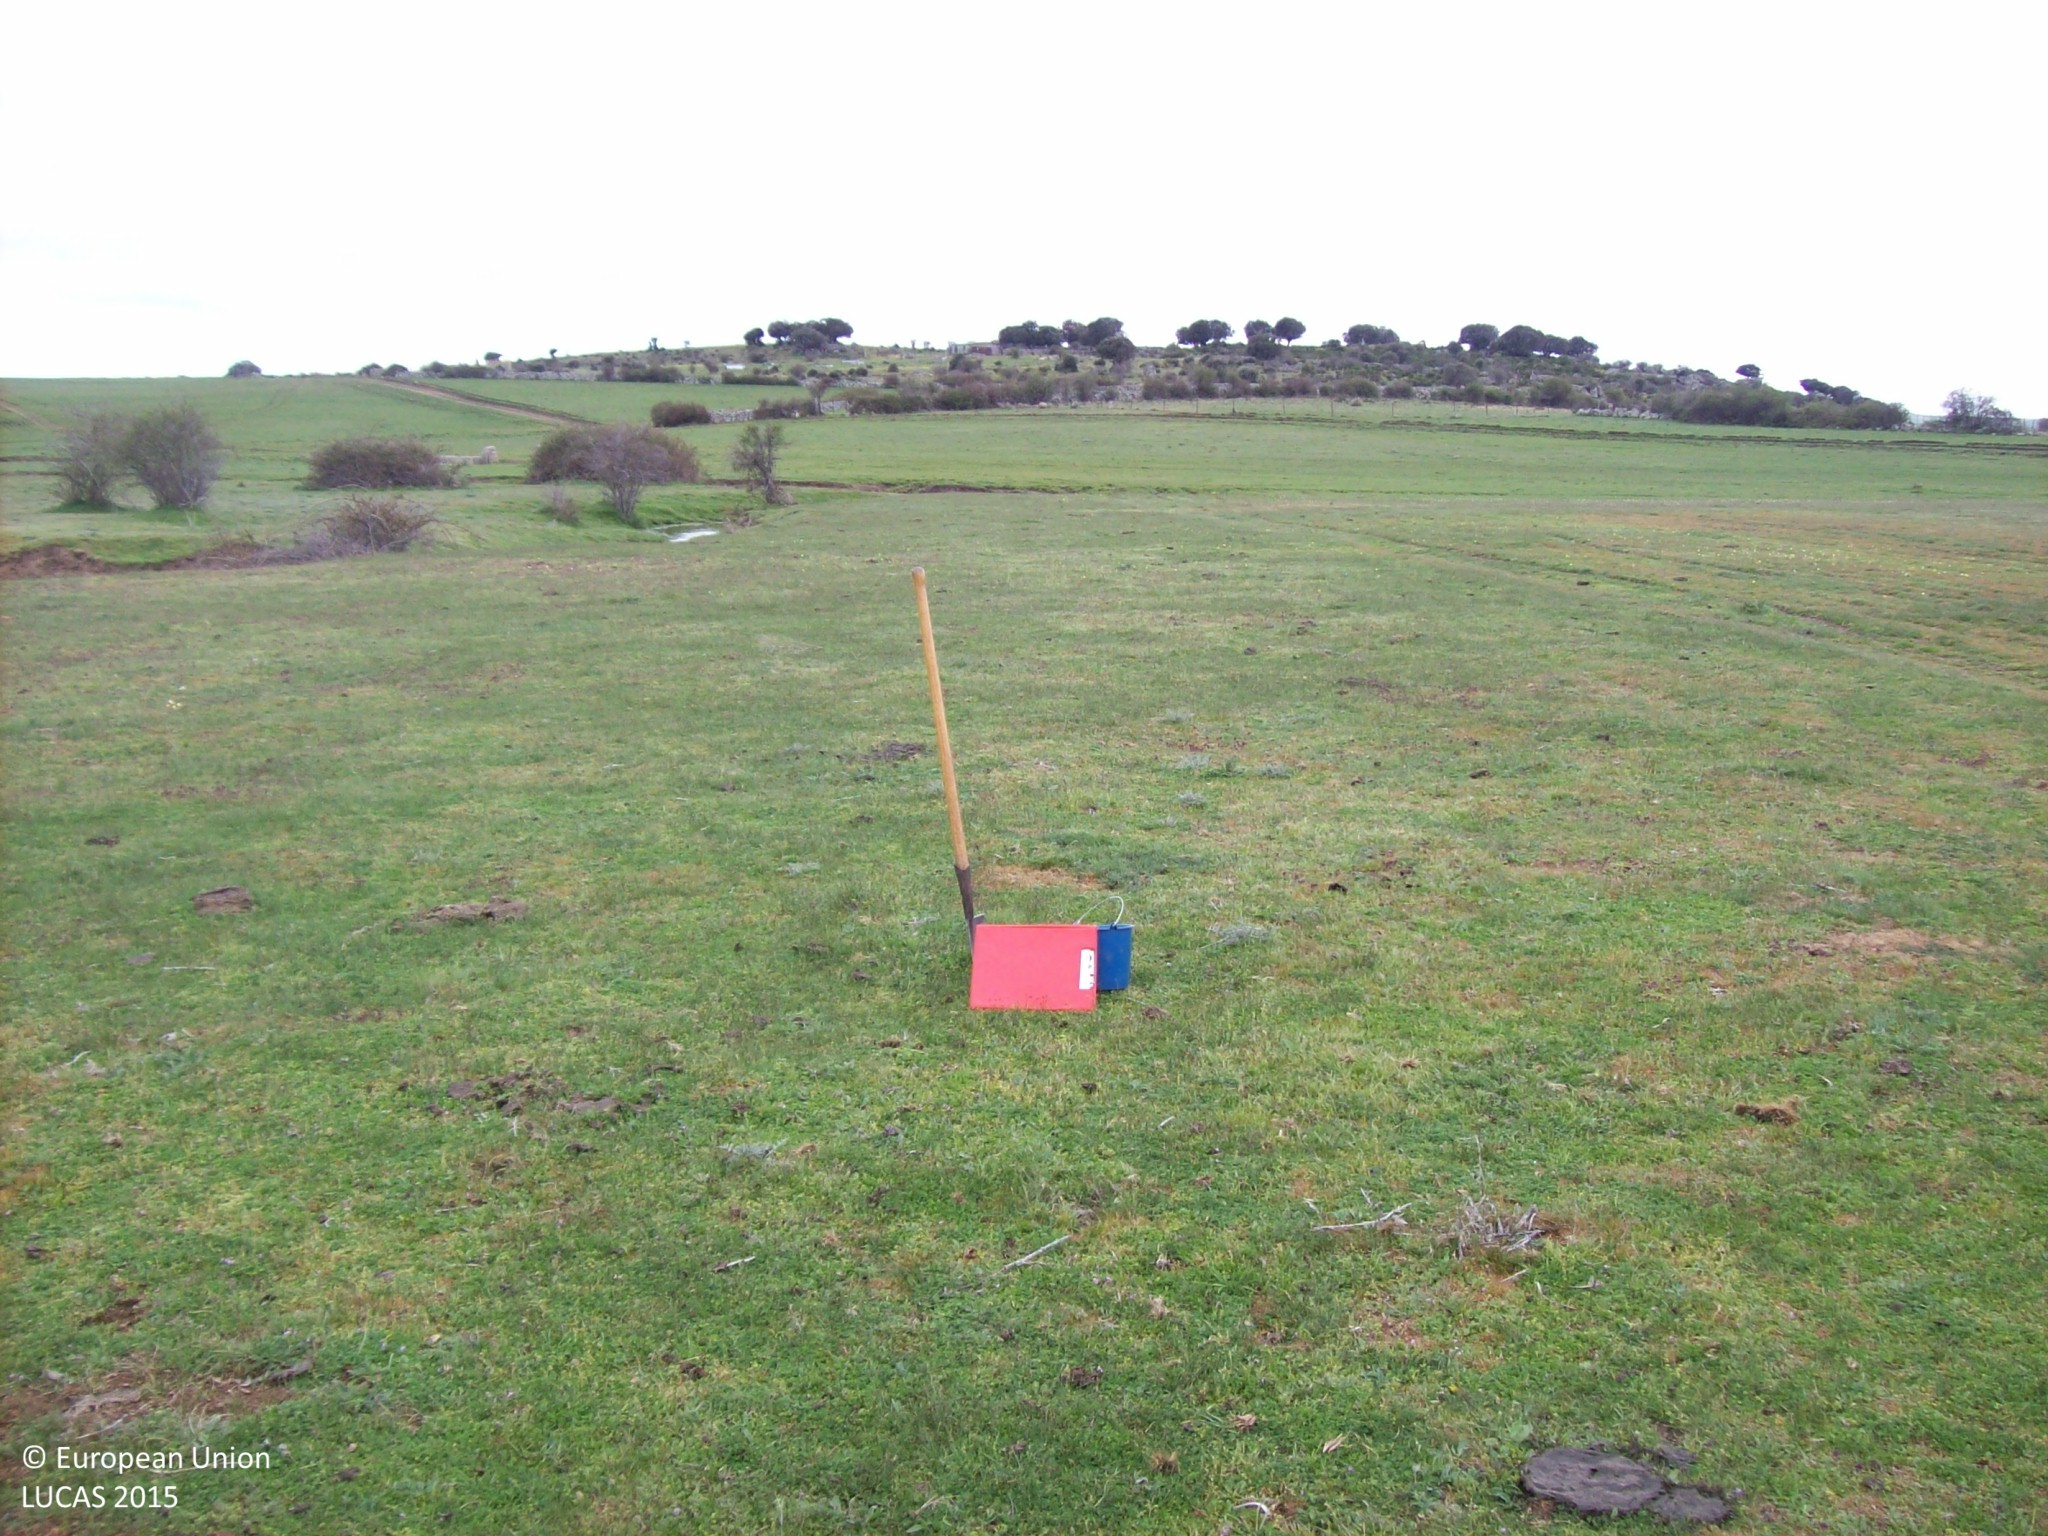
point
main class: Grassland
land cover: Grassland without tree/shrub cover
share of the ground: > 75 %
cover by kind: herbaceous plants 95 %
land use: Agriculture (excluding fallow land and kitchen gardens)
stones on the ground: < 10 %
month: April
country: ES
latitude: 40.5884
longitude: -4.4295
